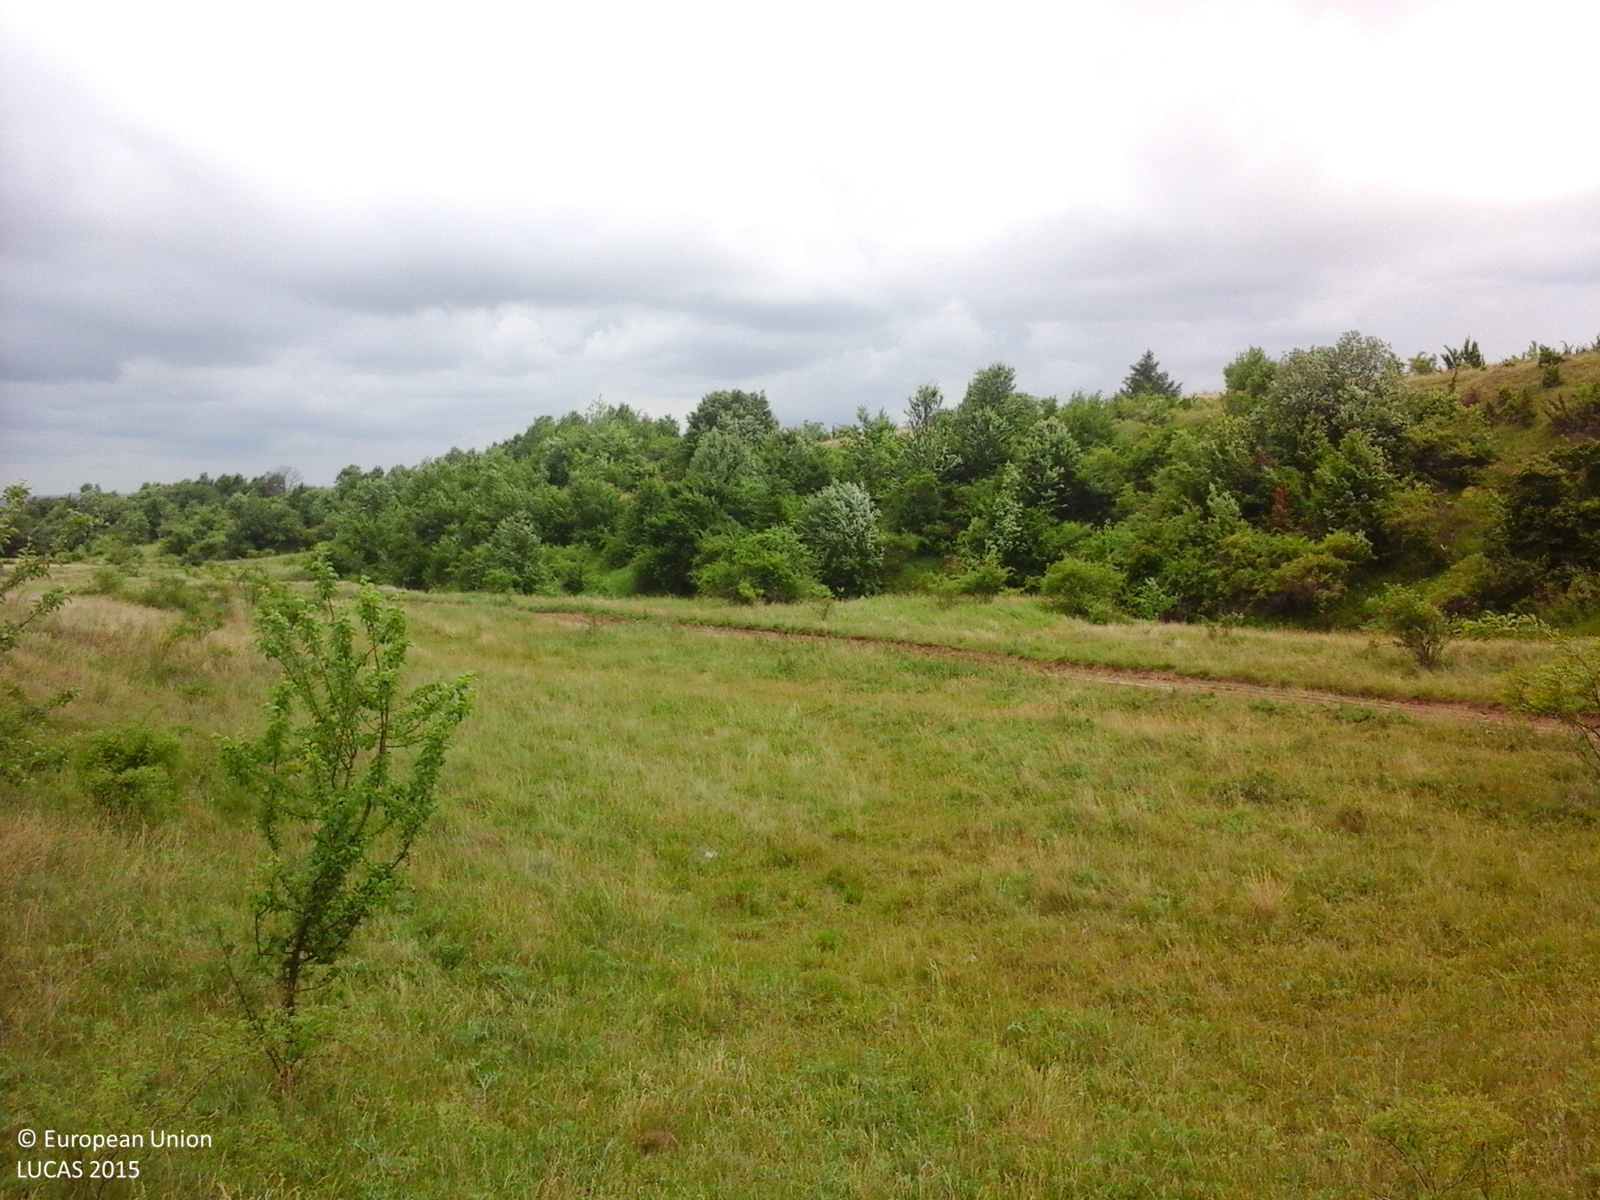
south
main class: Grassland
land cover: Grassland with sparse tree/shrub cover
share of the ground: > 75 %
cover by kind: herbaceous plants 85 %, shrubs 10 %, broadleaved forest trees 5 %
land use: Agriculture (excluding fallow land and kitchen gardens)
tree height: < 5 m
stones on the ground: < 10 %
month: June
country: RO
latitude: 47.1871
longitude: 26.2736
